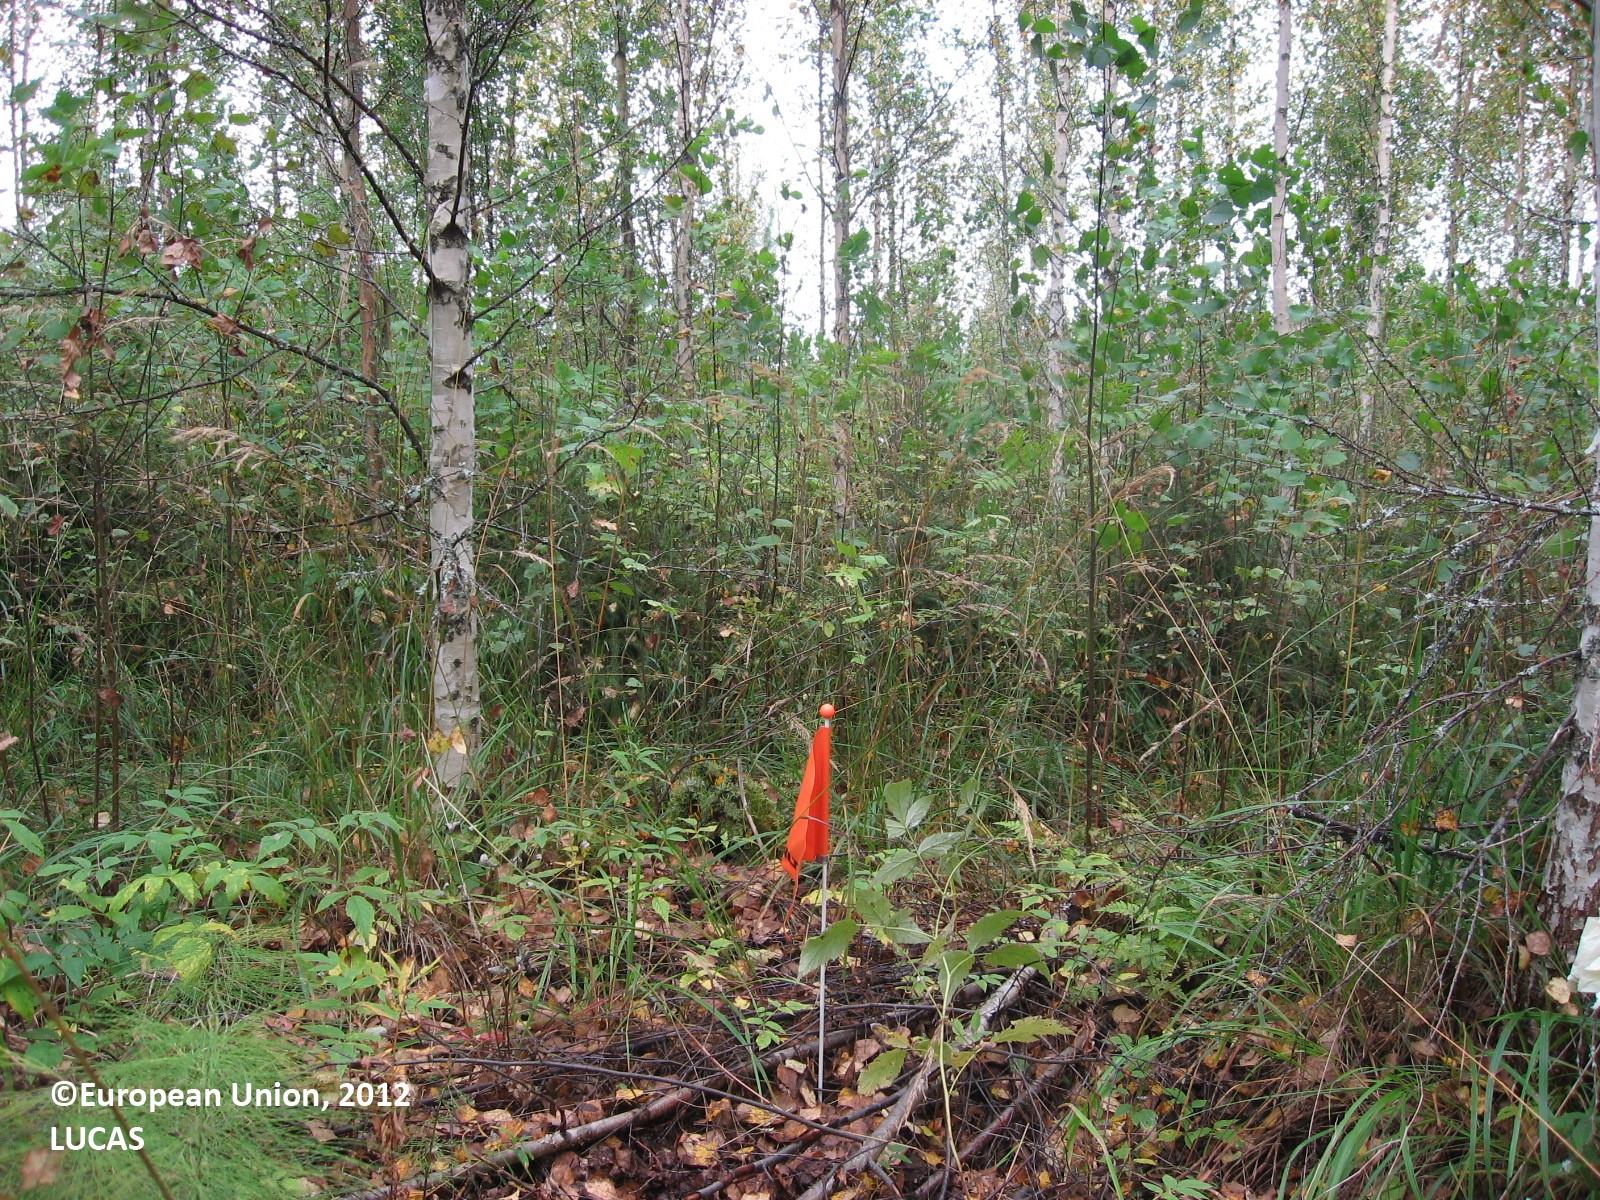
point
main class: Woodland
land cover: Broadleaved woodland
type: boreal forest
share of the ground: > 75 %
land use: Forestry
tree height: > 5 m
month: September
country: FI
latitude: 60.8797
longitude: 25.1685
